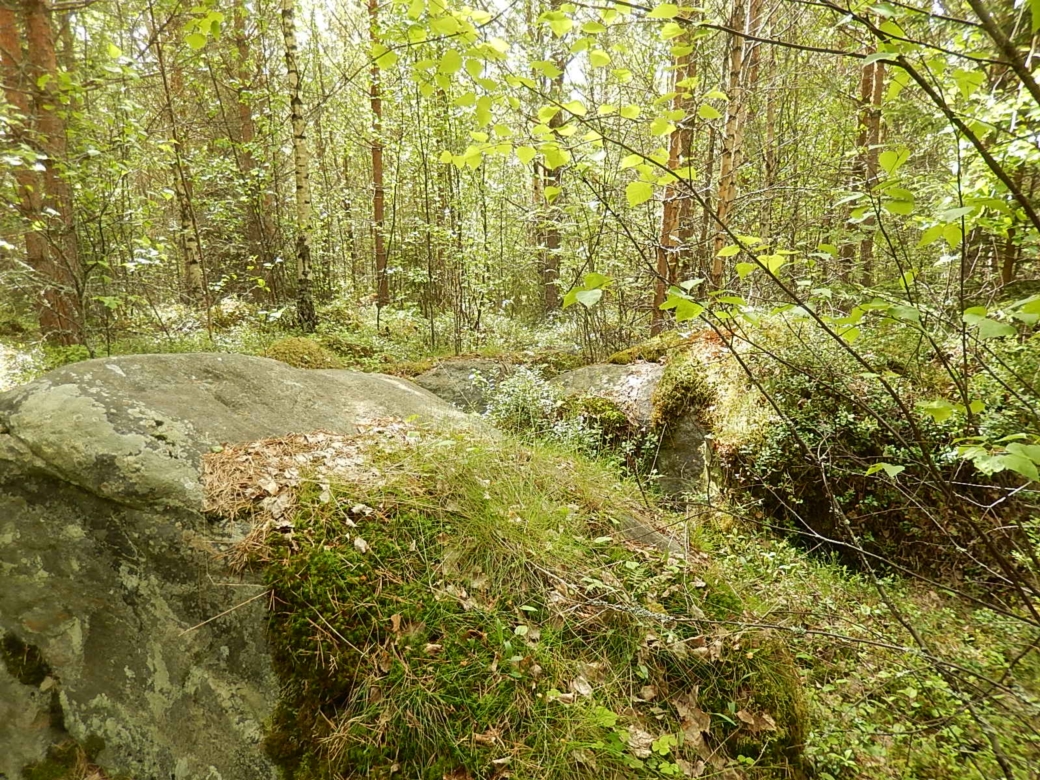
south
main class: Woodland
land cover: Pine dominated mixed woodland
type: boreal forest
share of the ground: > 75 %
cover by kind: coniferous forest trees 50 %, broadleaved forest trees 40 %, herbaceous plants 10 %
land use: Forestry
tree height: > 5 m
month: June
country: FI
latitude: 61.8800
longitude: 21.4780
